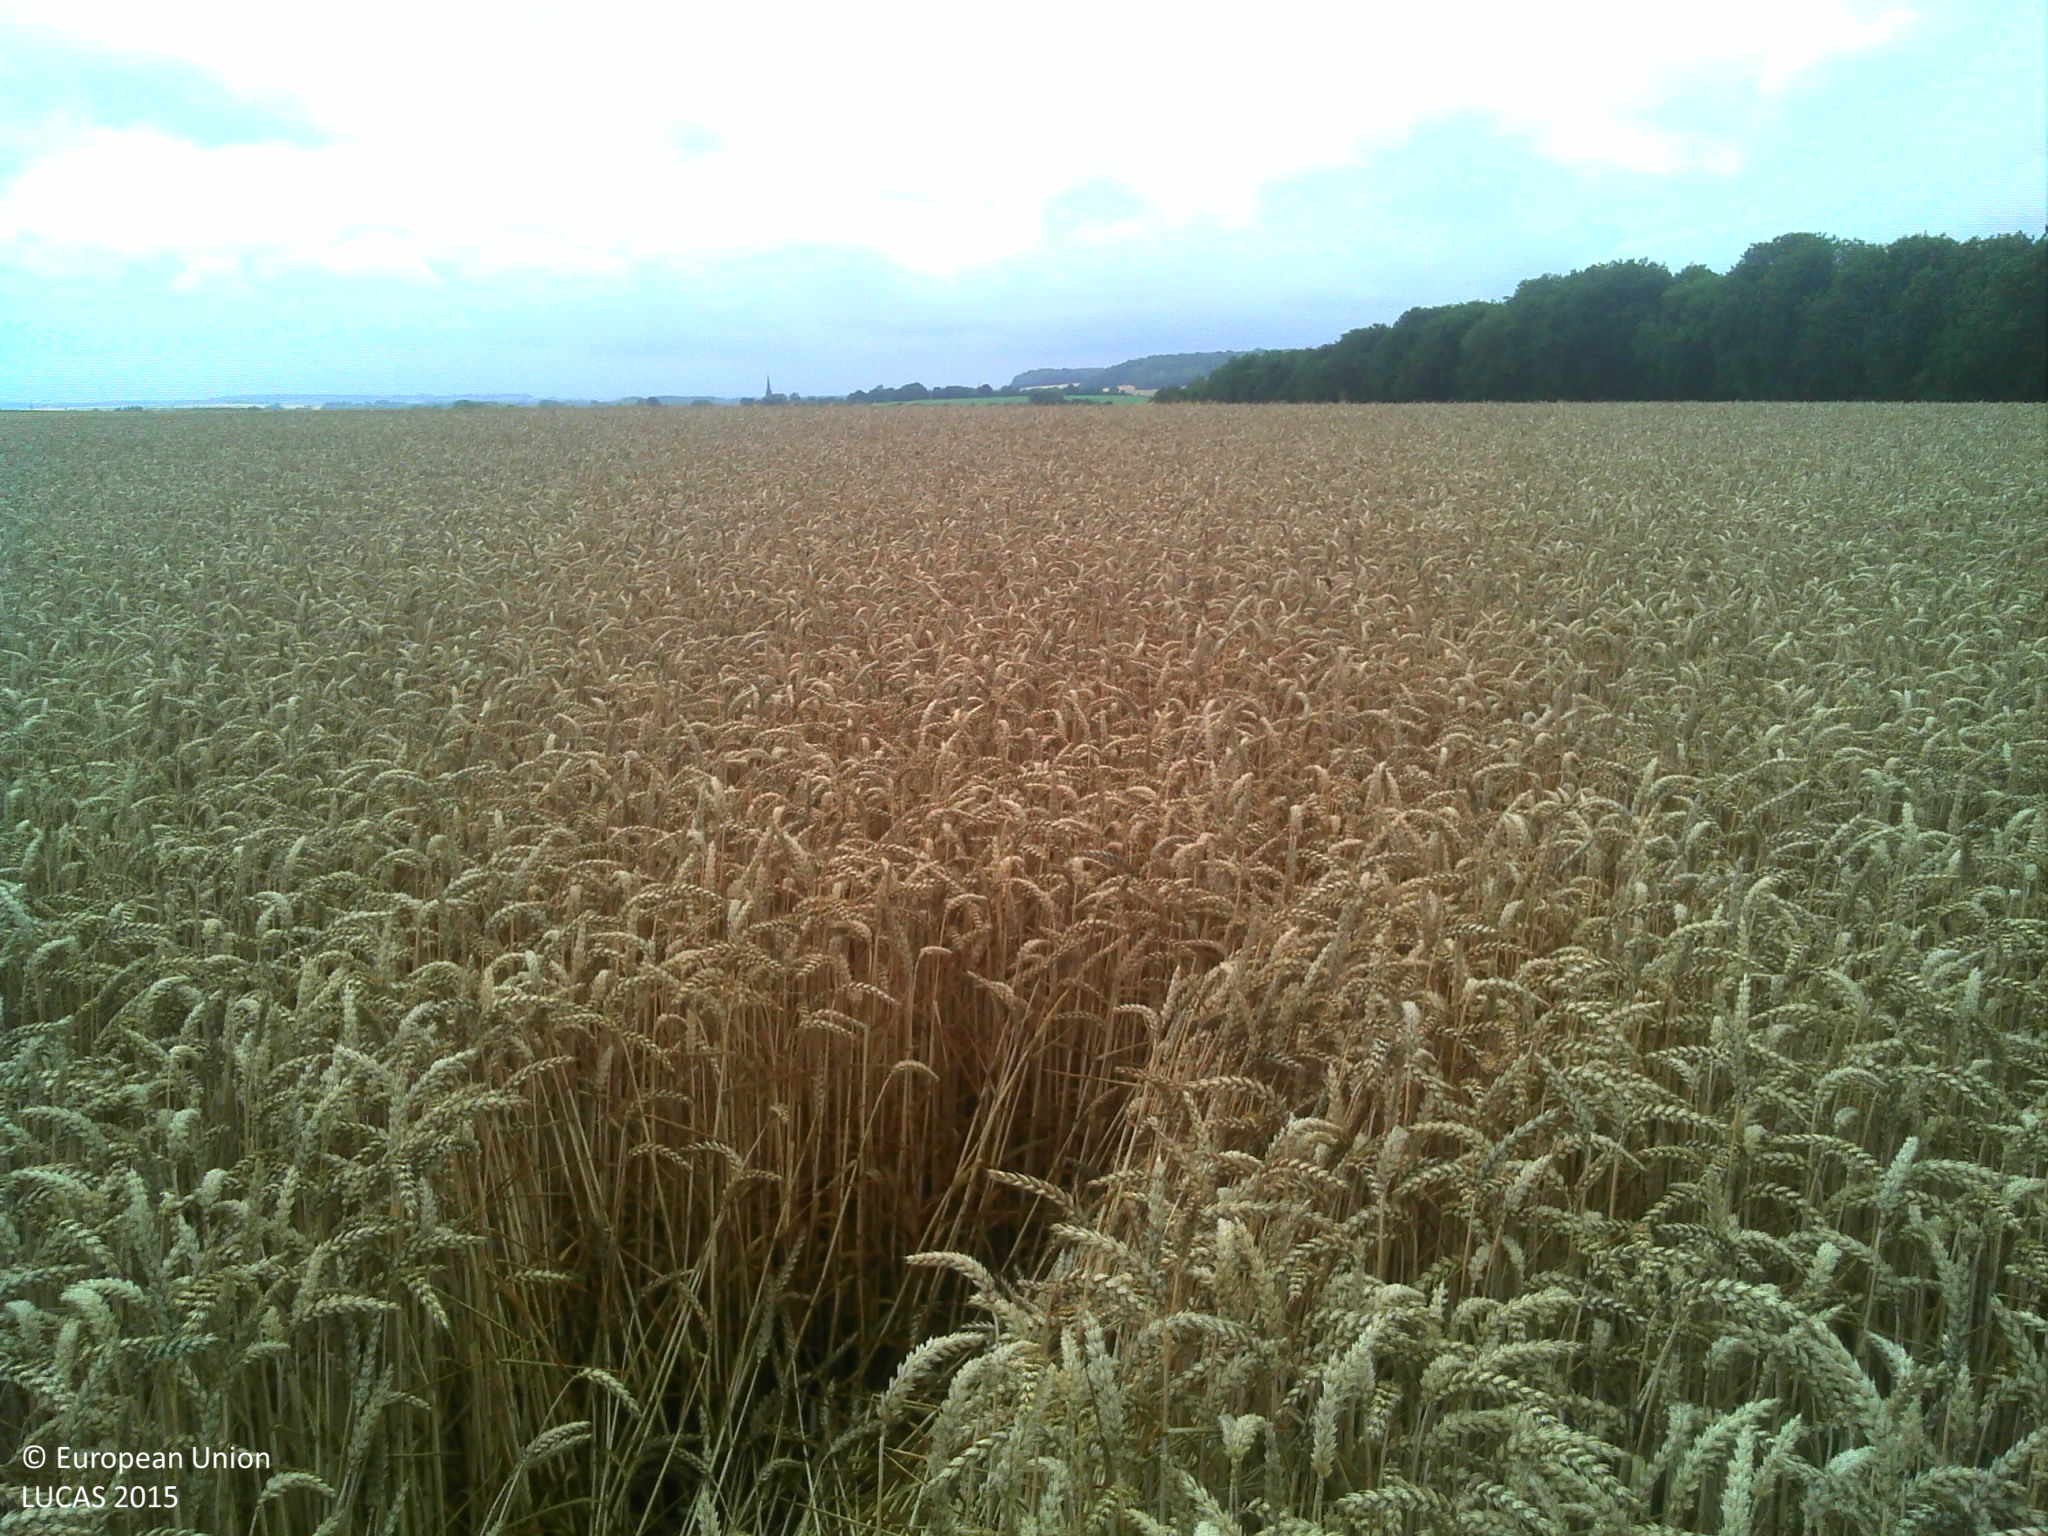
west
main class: Cropland
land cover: Common wheat
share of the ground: > 75 %
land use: Agriculture (excluding fallow land and kitchen gardens)
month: July
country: FR
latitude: 49.7010
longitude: 3.6570
